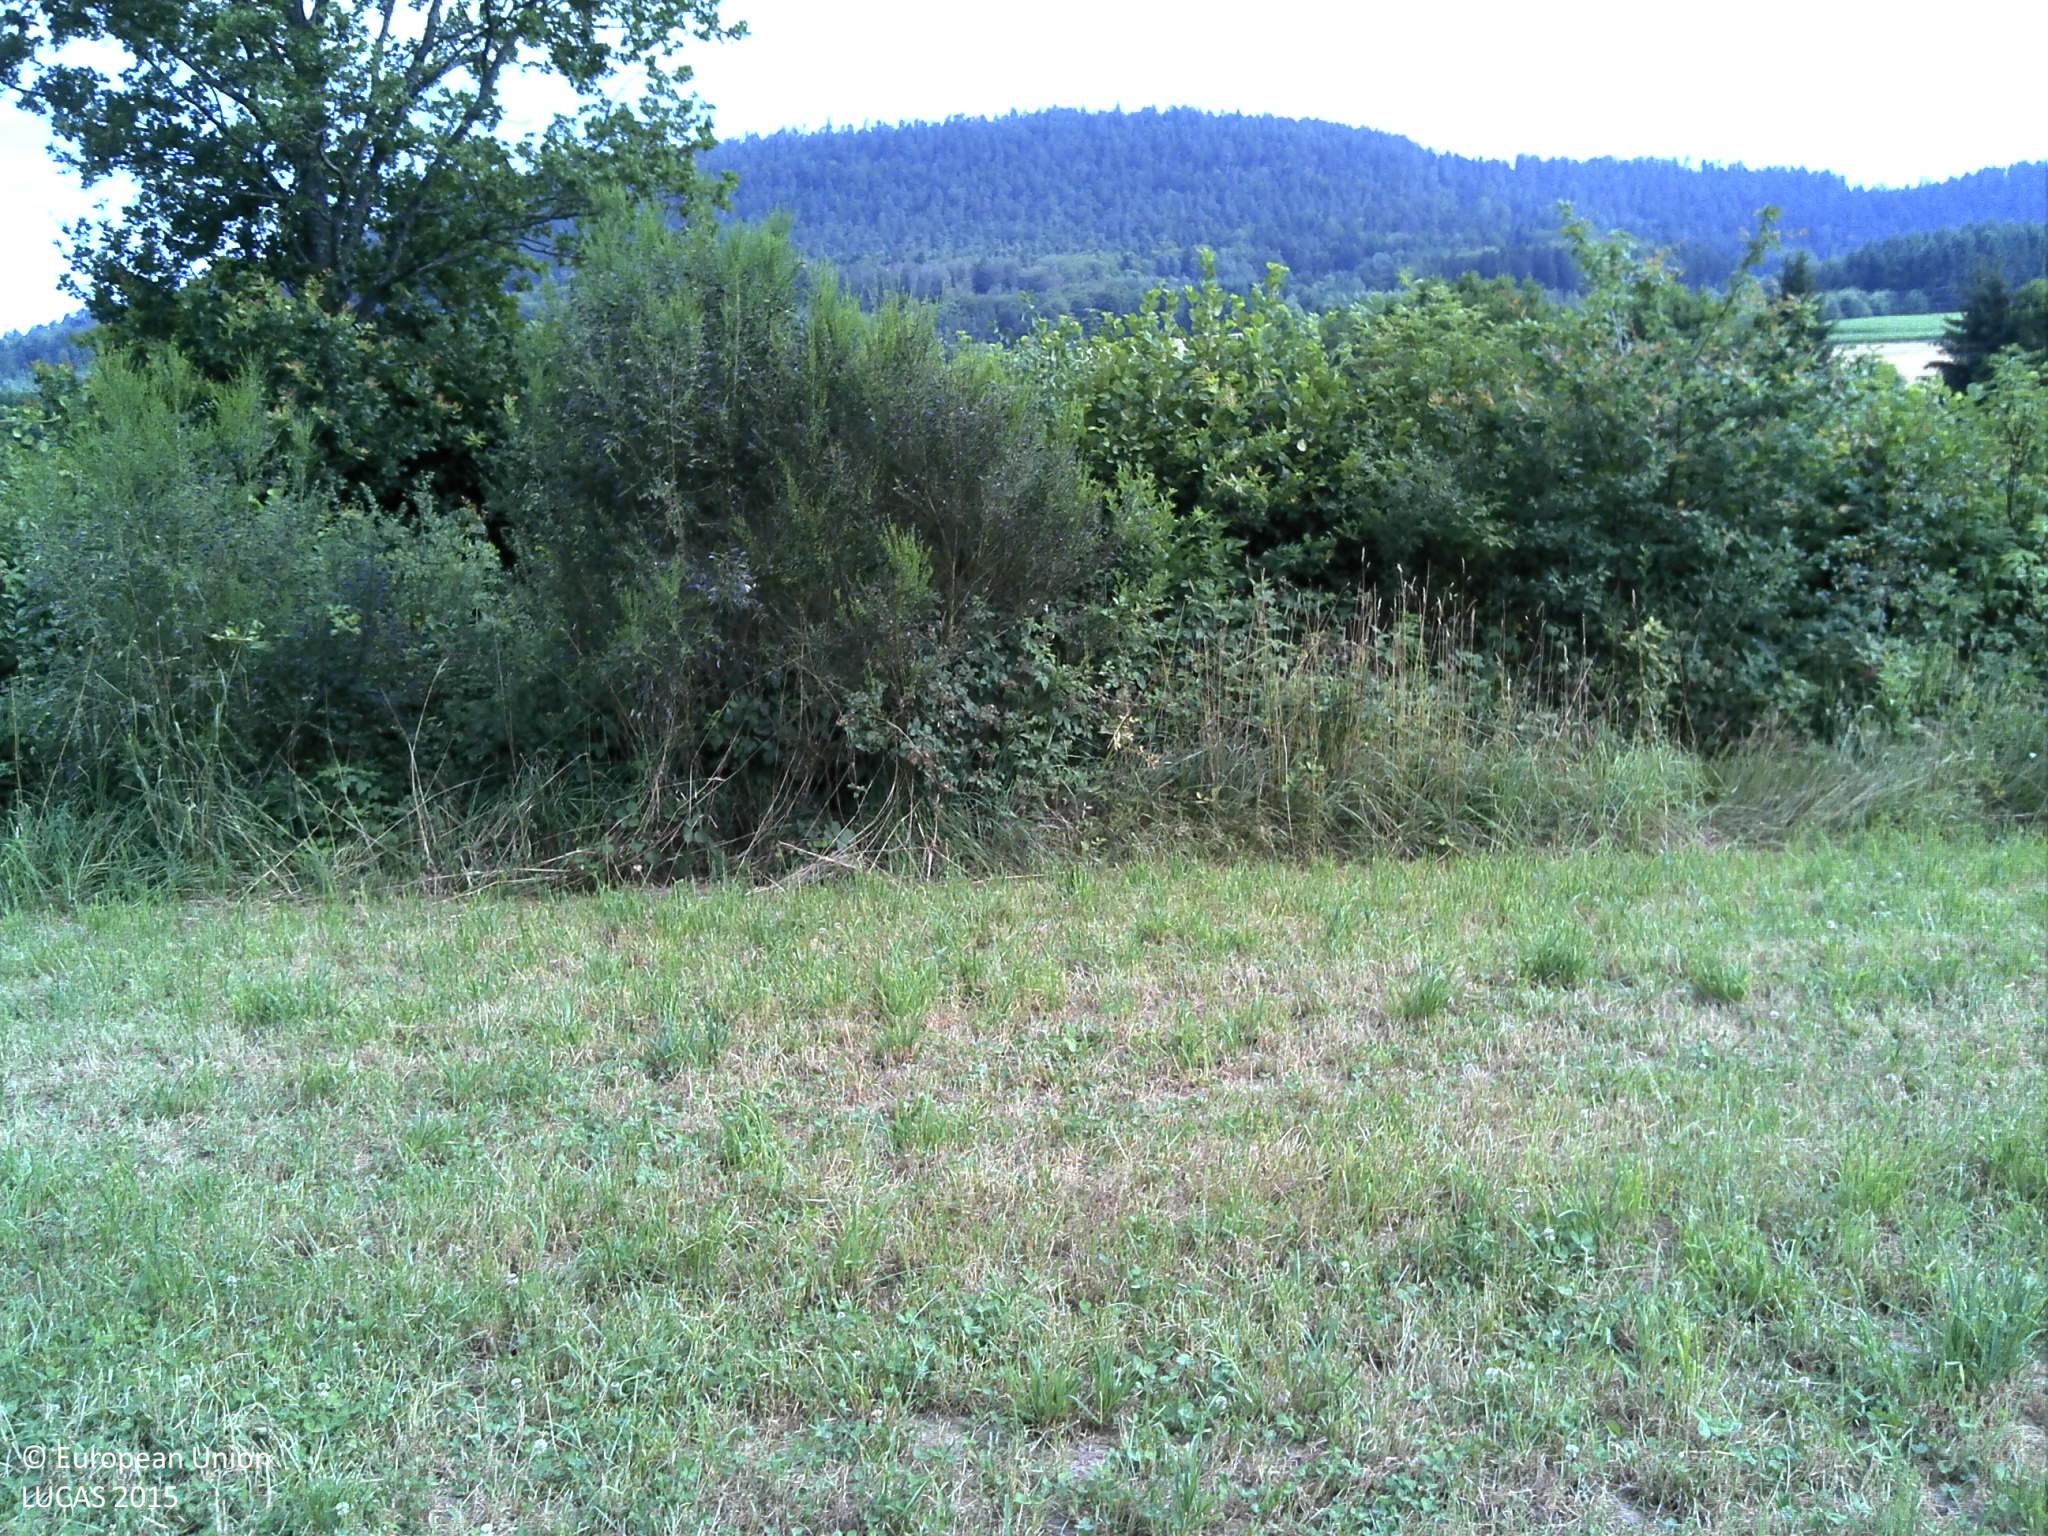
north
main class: Grassland
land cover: Grassland without tree/shrub cover
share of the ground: > 75 %
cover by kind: herbaceous plants 100 %
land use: Agriculture (excluding fallow land and kitchen gardens)
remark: Harvested field
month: July
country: FR
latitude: 48.1775
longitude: 6.8136
